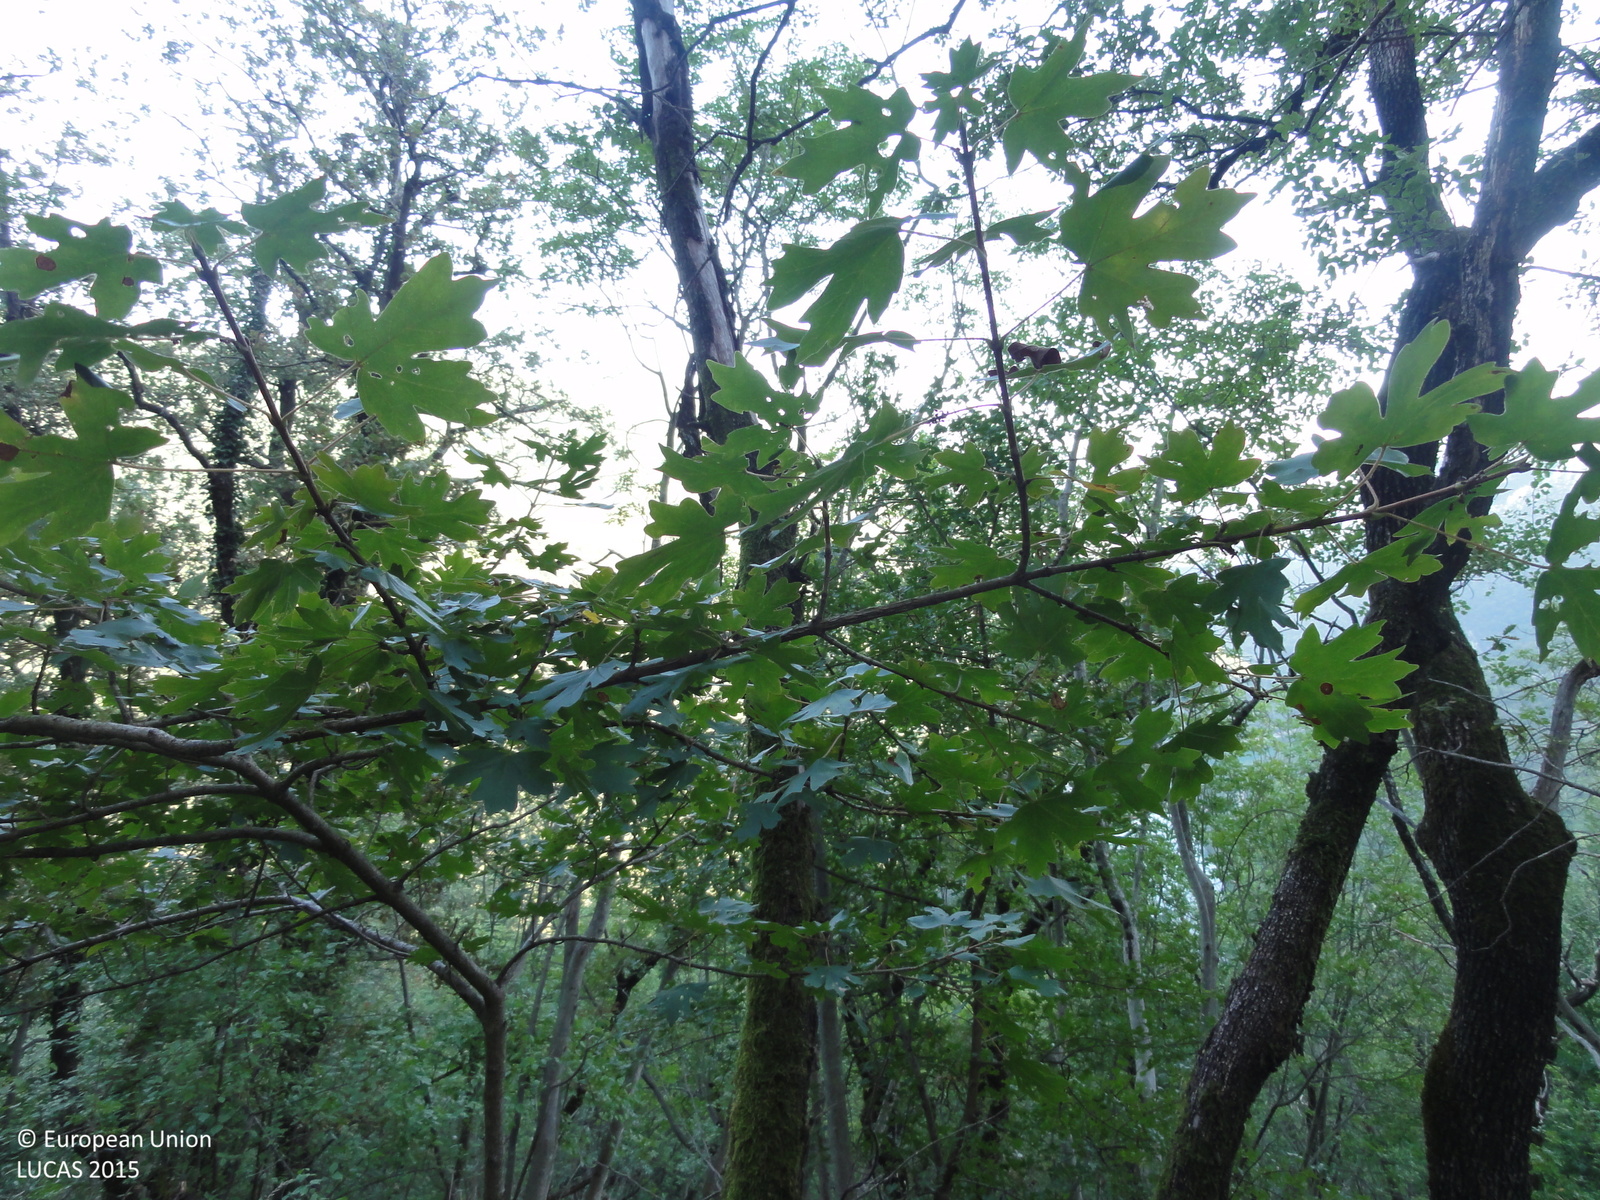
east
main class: Woodland
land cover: Broadleaved woodland
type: thermophilous deciduous forest
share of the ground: > 75 %
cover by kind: broadleaved forest trees 80 %, herbaceous plants 15 %, shrubs 5 %
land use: Semi-natural and natural areas not in use
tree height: > 5 m
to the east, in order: Broadleaved woodland; Tracks; Broadleaved woodland; Tracks; Broadleaved woodland
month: August
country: SI
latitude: 46.0202
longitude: 13.6001
